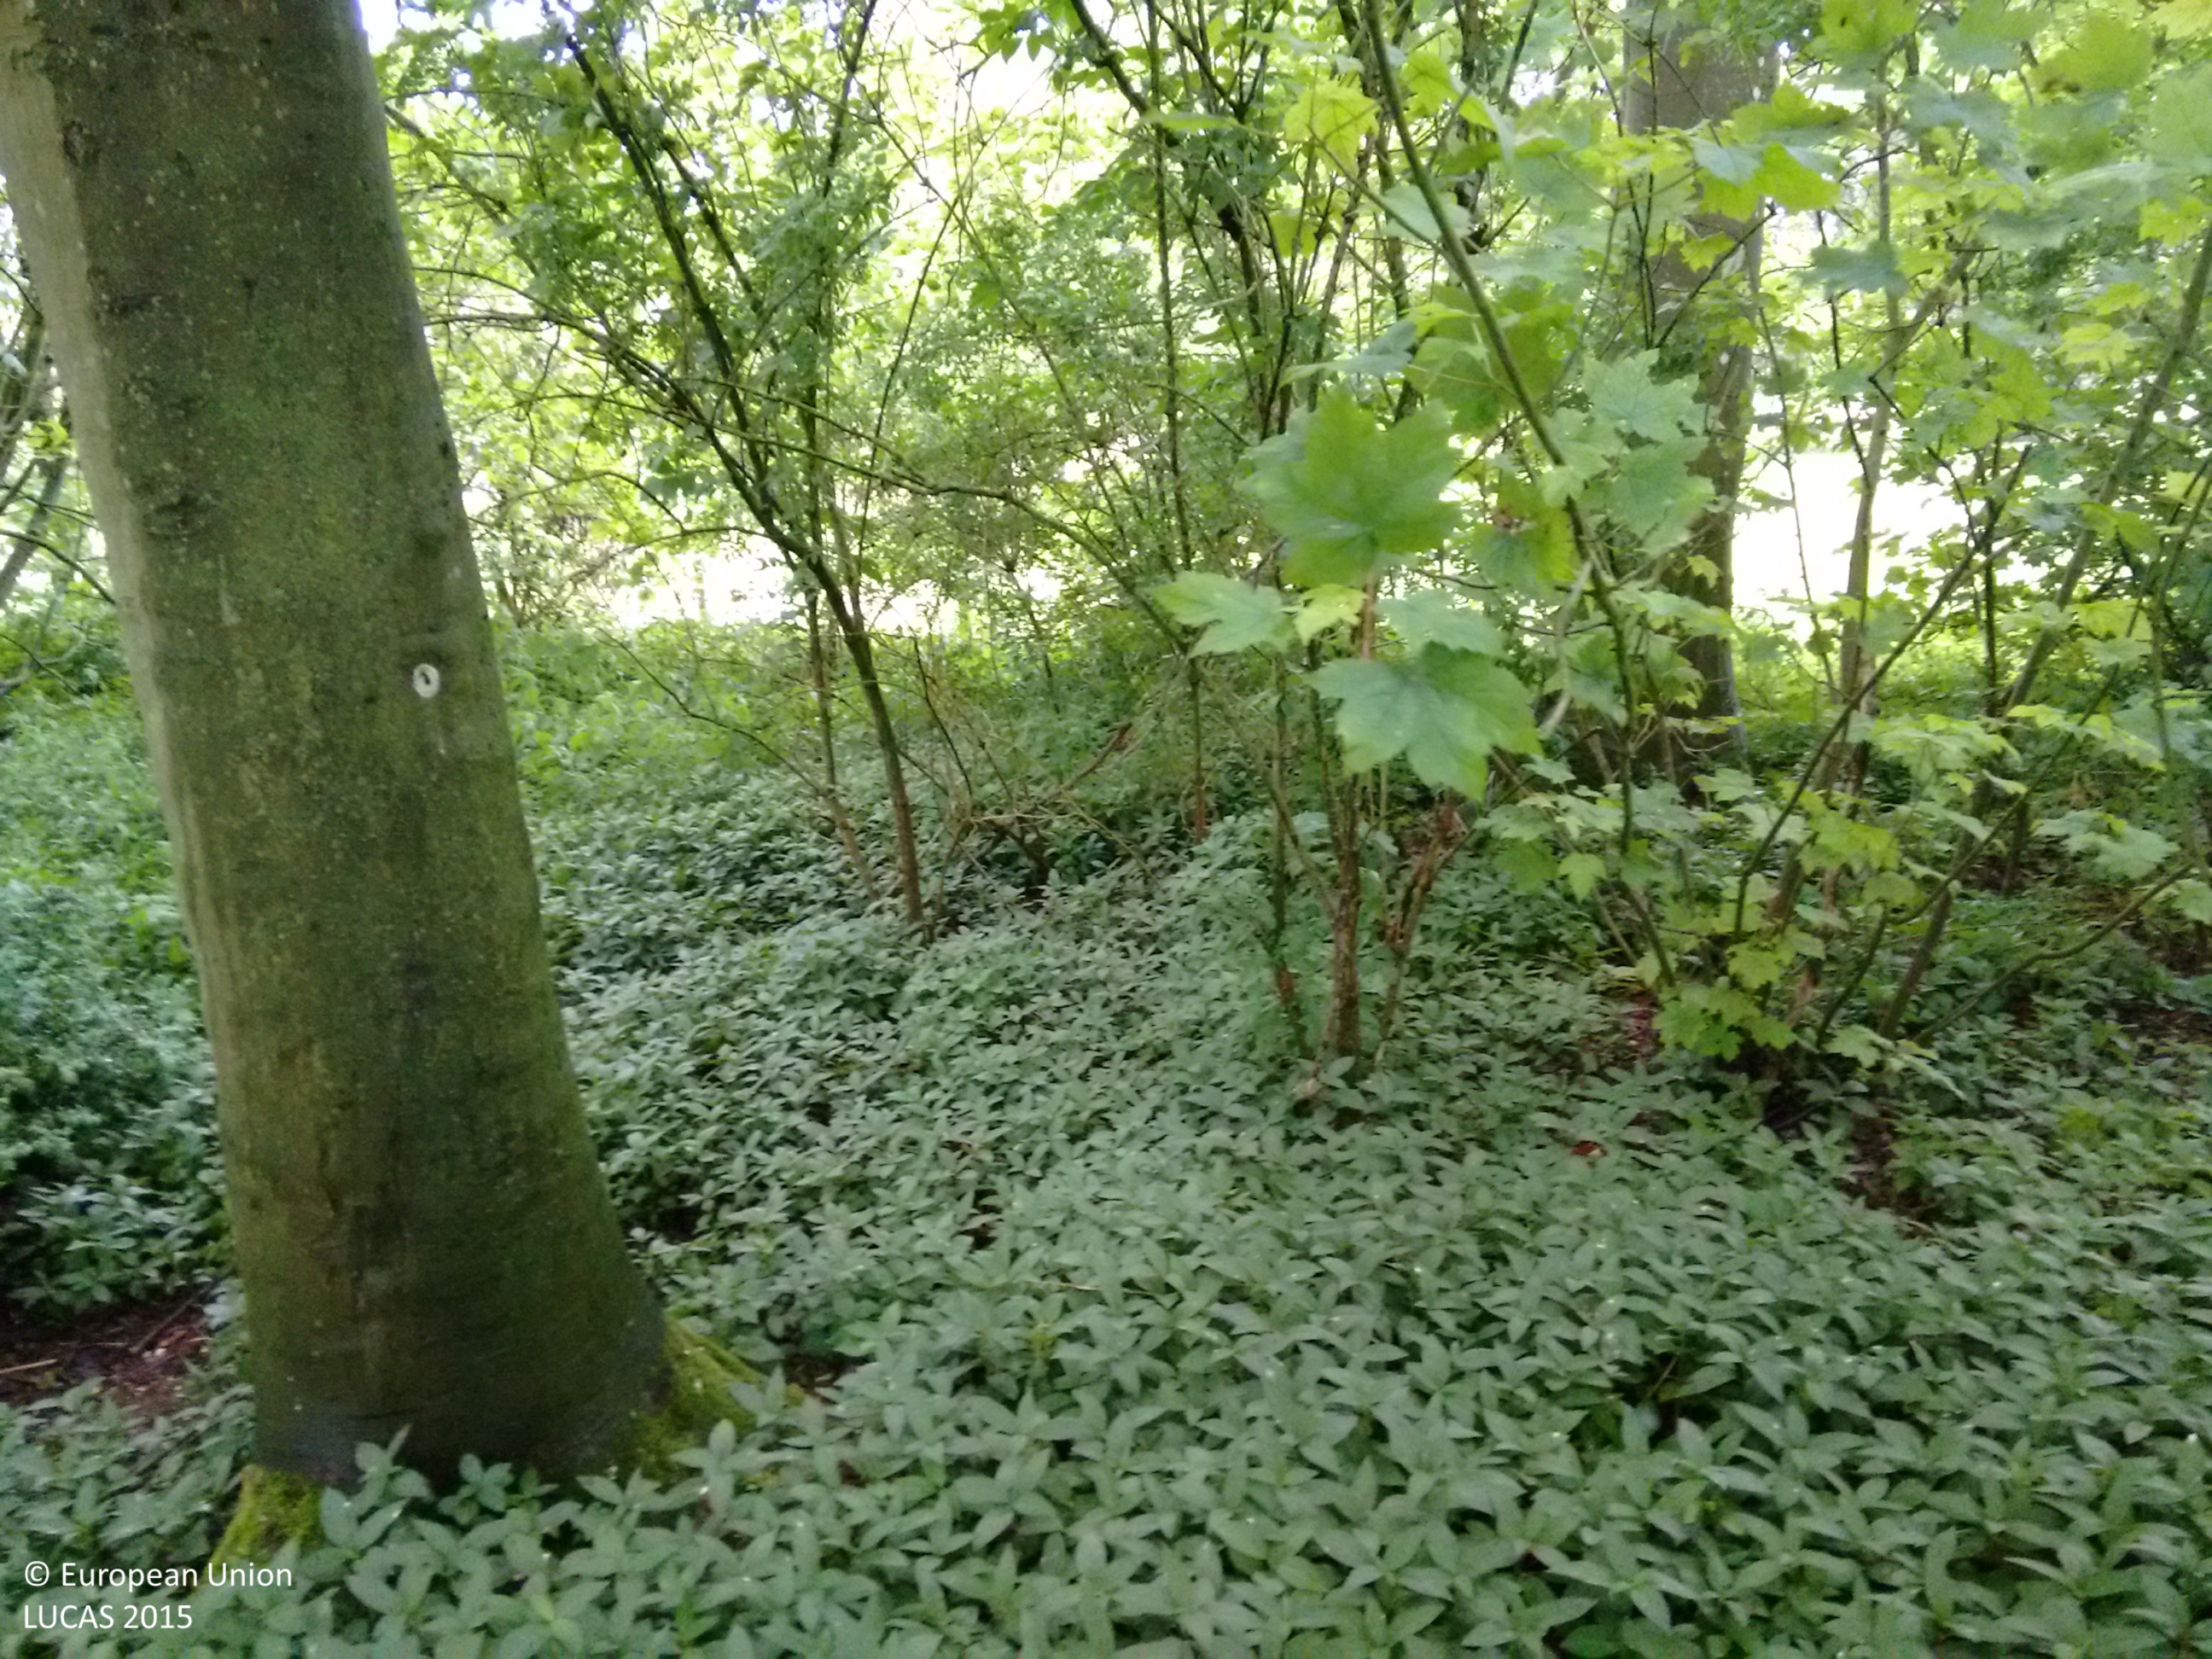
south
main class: Woodland
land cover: Broadleaved woodland
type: mesophytic deciduous forest
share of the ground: > 75 %
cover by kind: broadleaved forest trees 90 %, shrubs 10 %
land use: Agriculture (excluding fallow land and kitchen gardens)
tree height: > 5 m
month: June
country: GB
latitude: 51.1598
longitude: -1.1568
